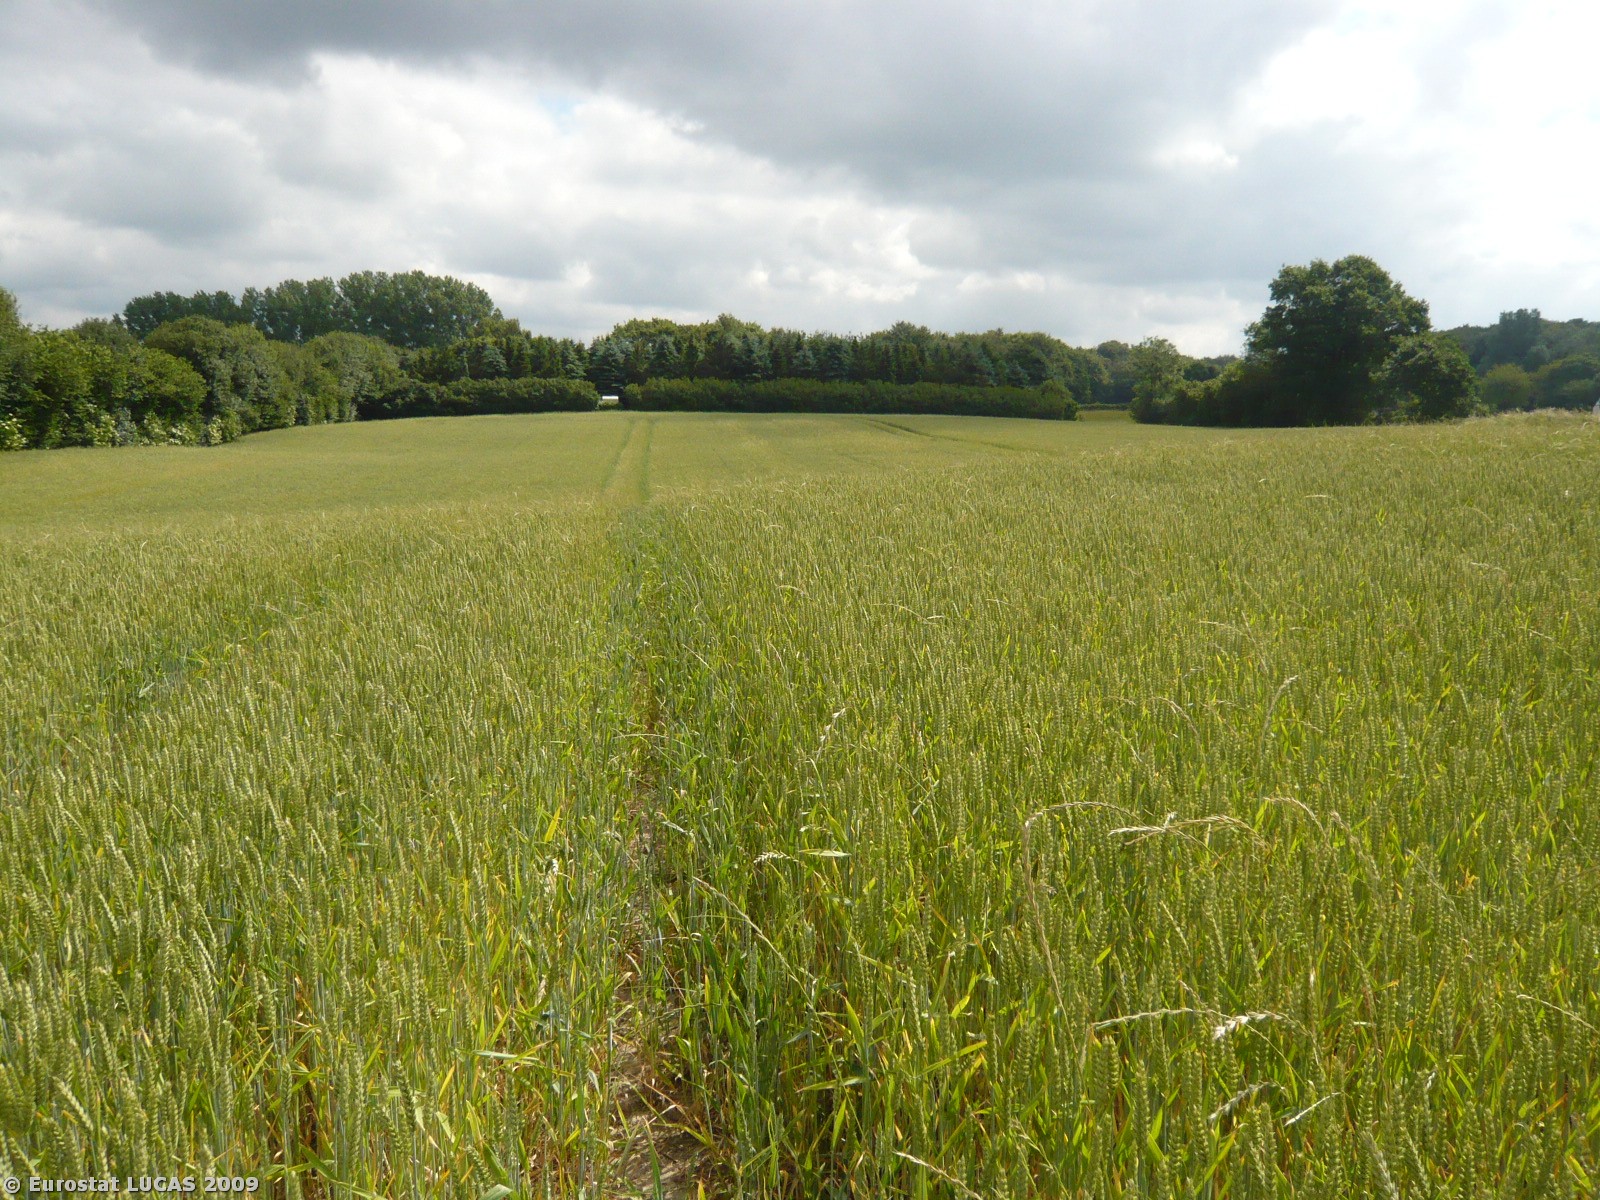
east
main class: Cropland
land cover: Common wheat
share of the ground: > 75 %
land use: Agriculture (excluding fallow land and kitchen gardens)
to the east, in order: Common wheat; Broadleaved woodland; Artificial constructions in urban areas
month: June
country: DK
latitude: 55.2709
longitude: 10.1730
